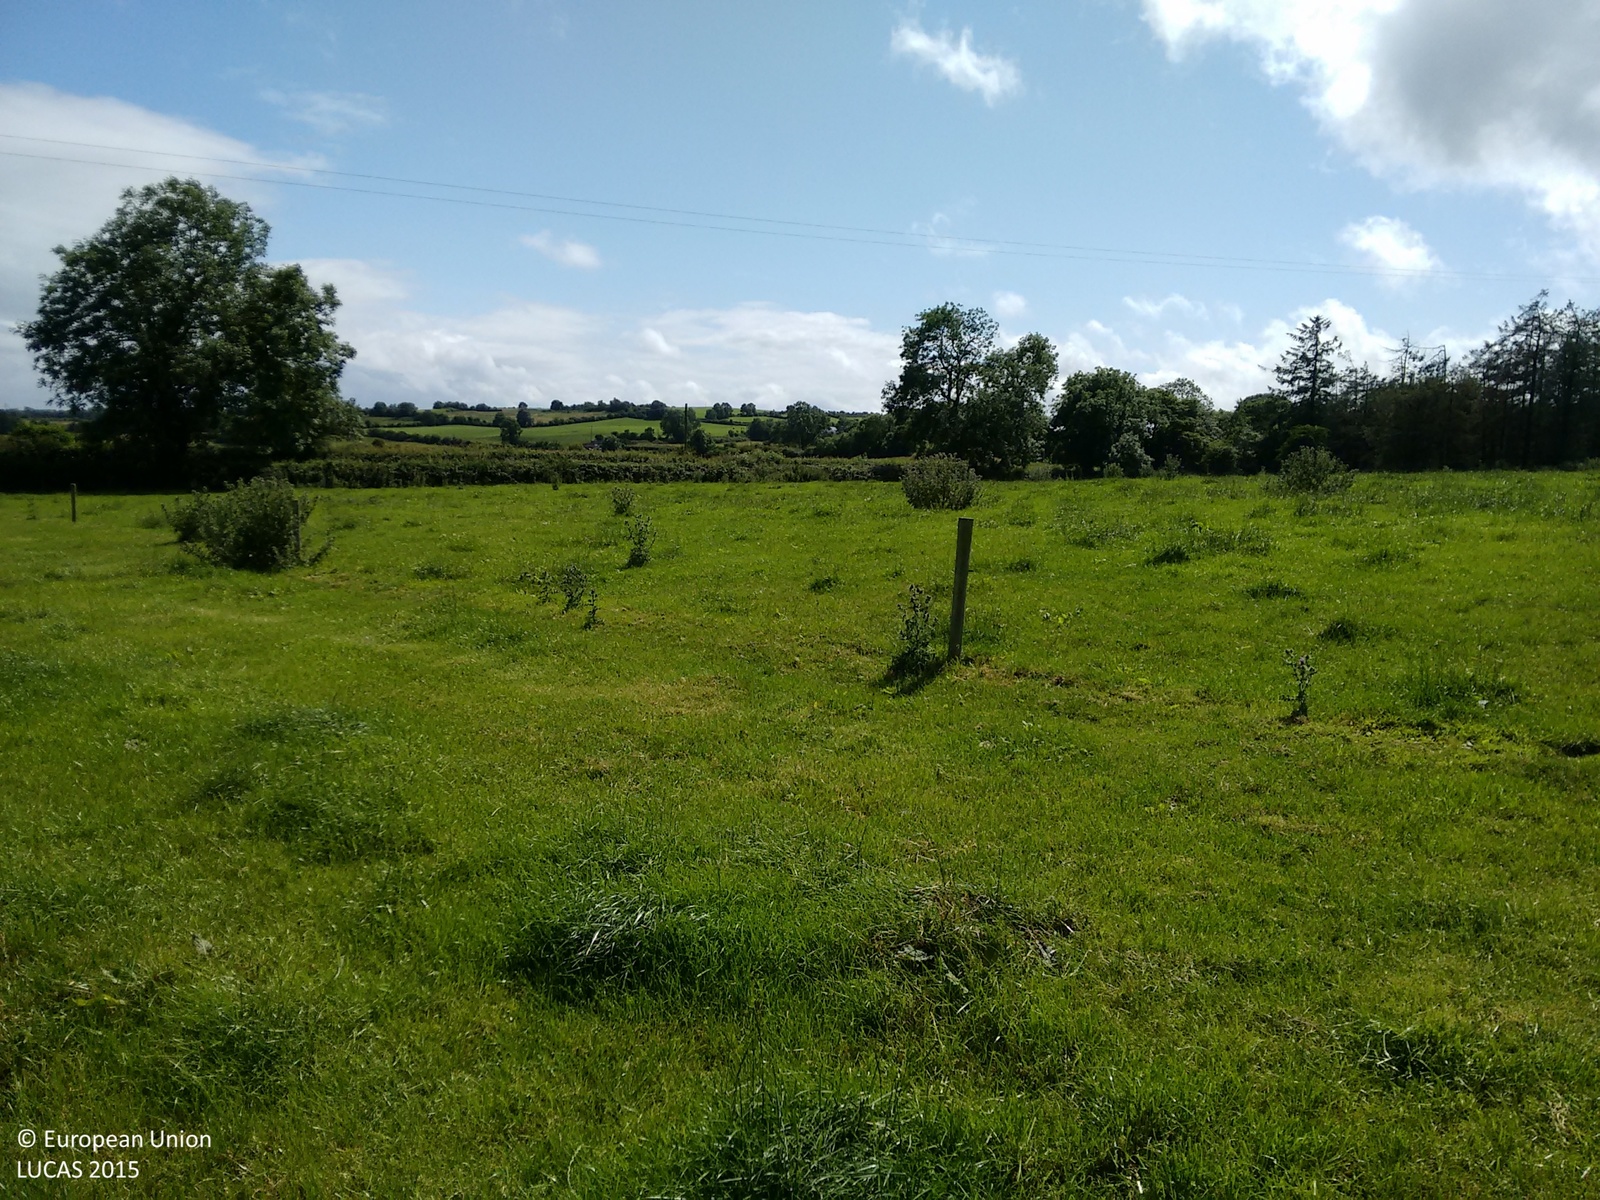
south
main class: Grassland
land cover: Grassland without tree/shrub cover
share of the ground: > 75 %
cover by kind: herbaceous plants 100 %
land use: Agriculture (excluding fallow land and kitchen gardens)
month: July
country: IE
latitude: 52.6951
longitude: -7.4238
